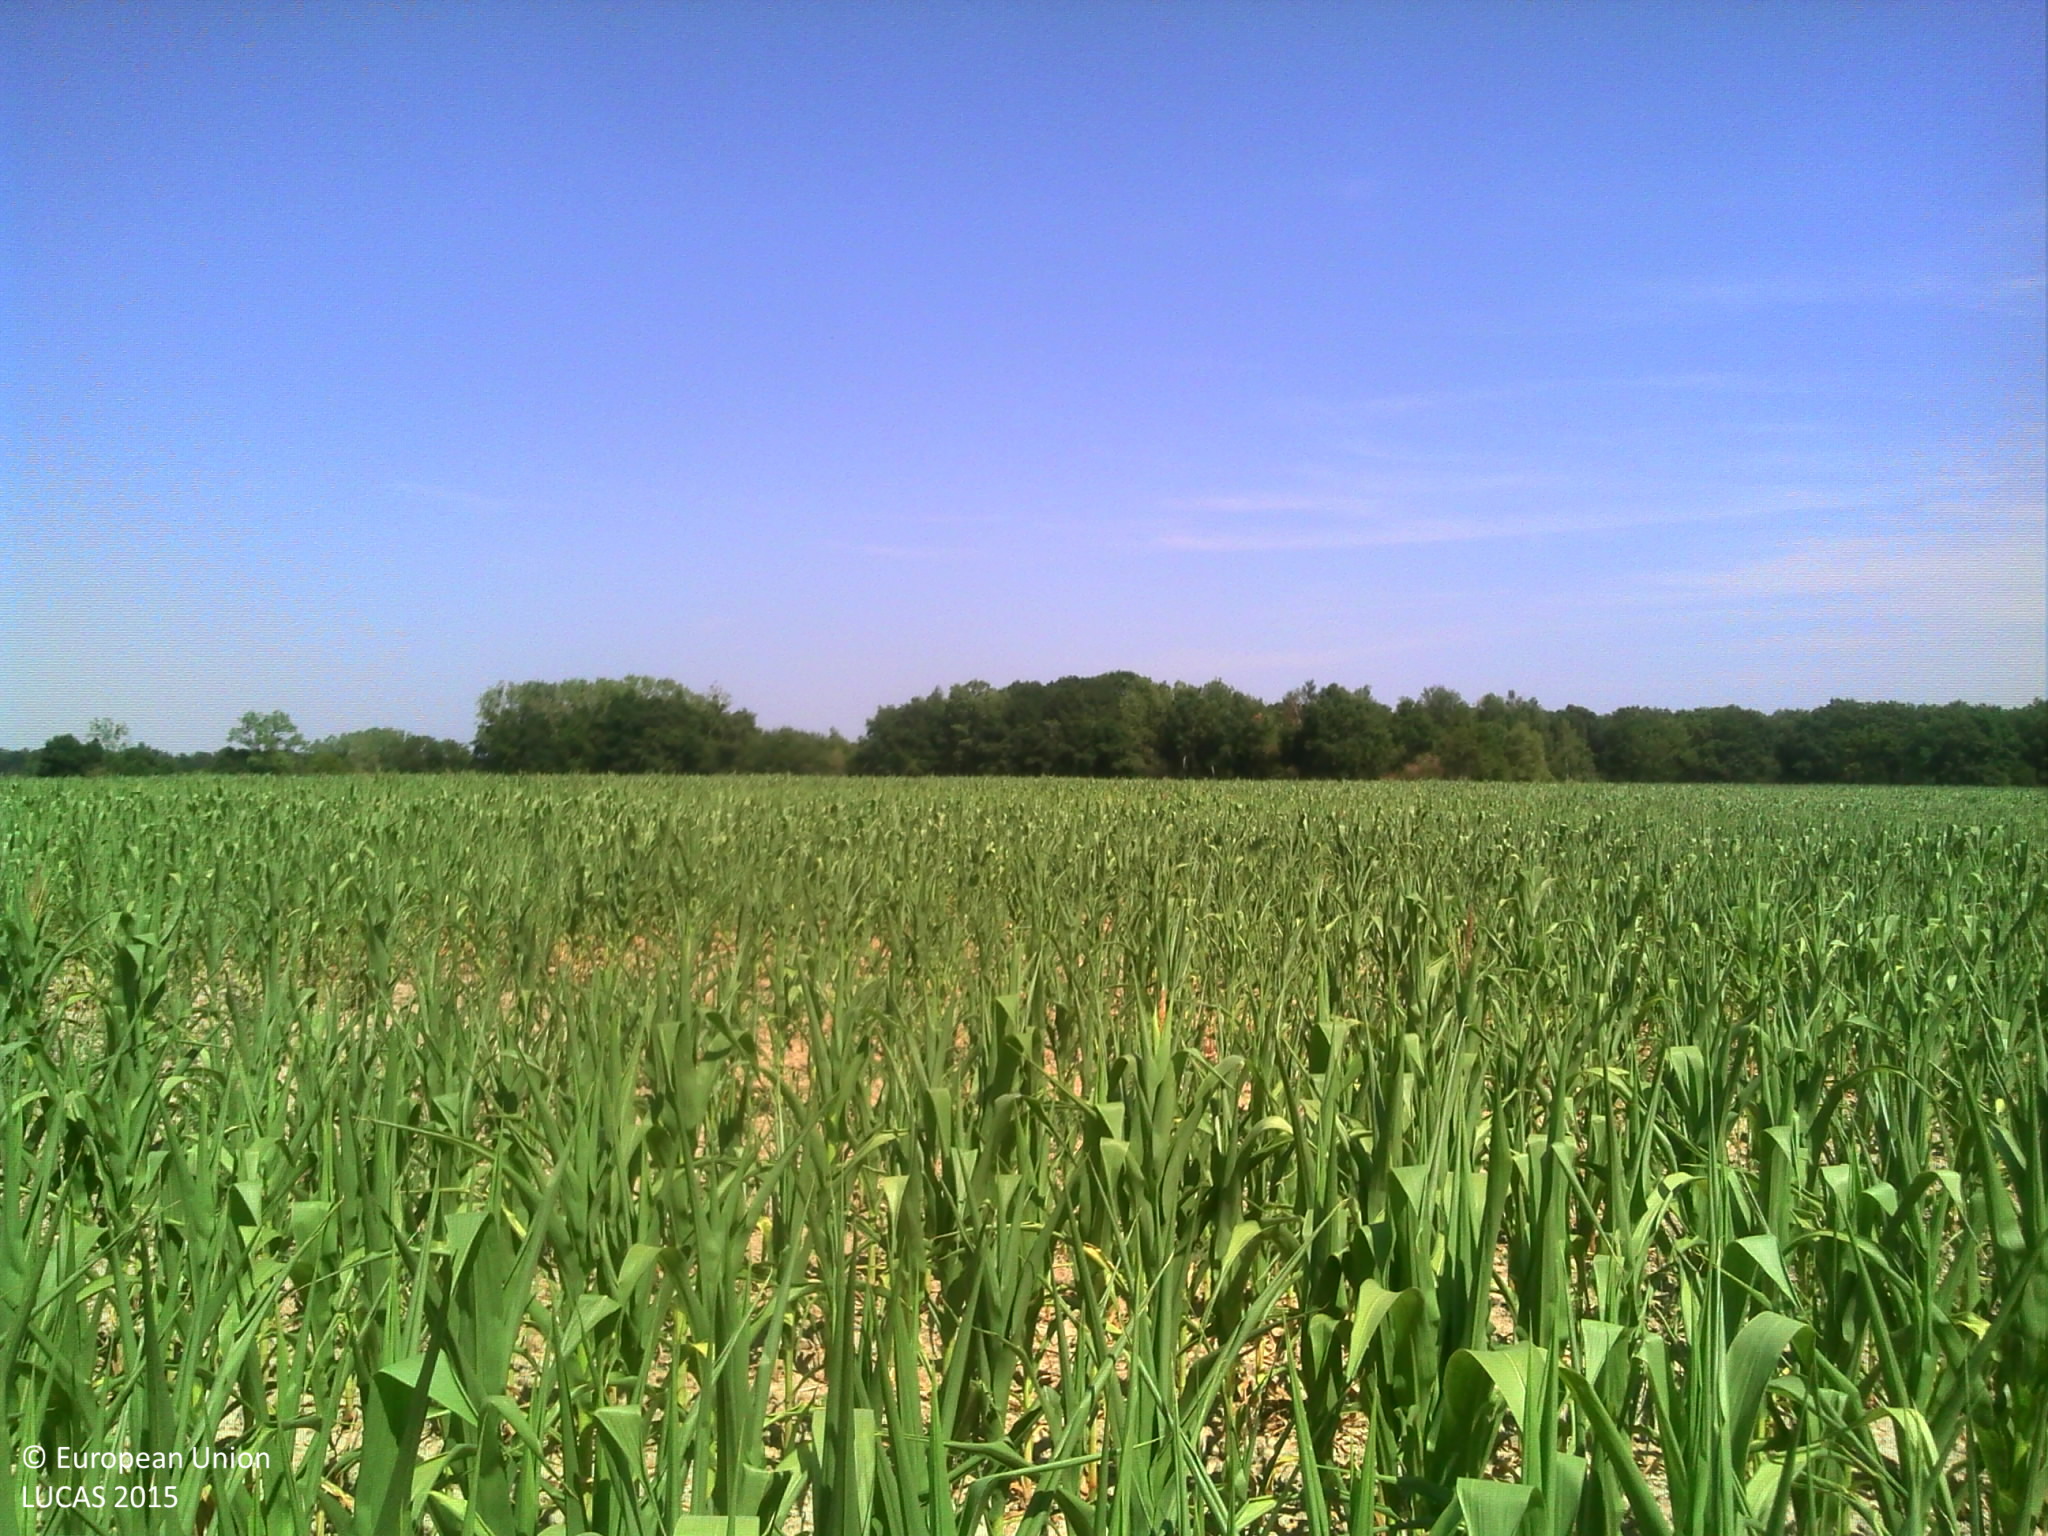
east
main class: Cropland
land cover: Maize
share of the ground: > 75 %
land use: Agriculture (excluding fallow land and kitchen gardens)
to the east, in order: Maize; Ditches and canals; Grass margins; Tracks; Grass margins; Ditches and canals; Maize
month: July
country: FR
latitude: 46.7270
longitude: 5.1212
